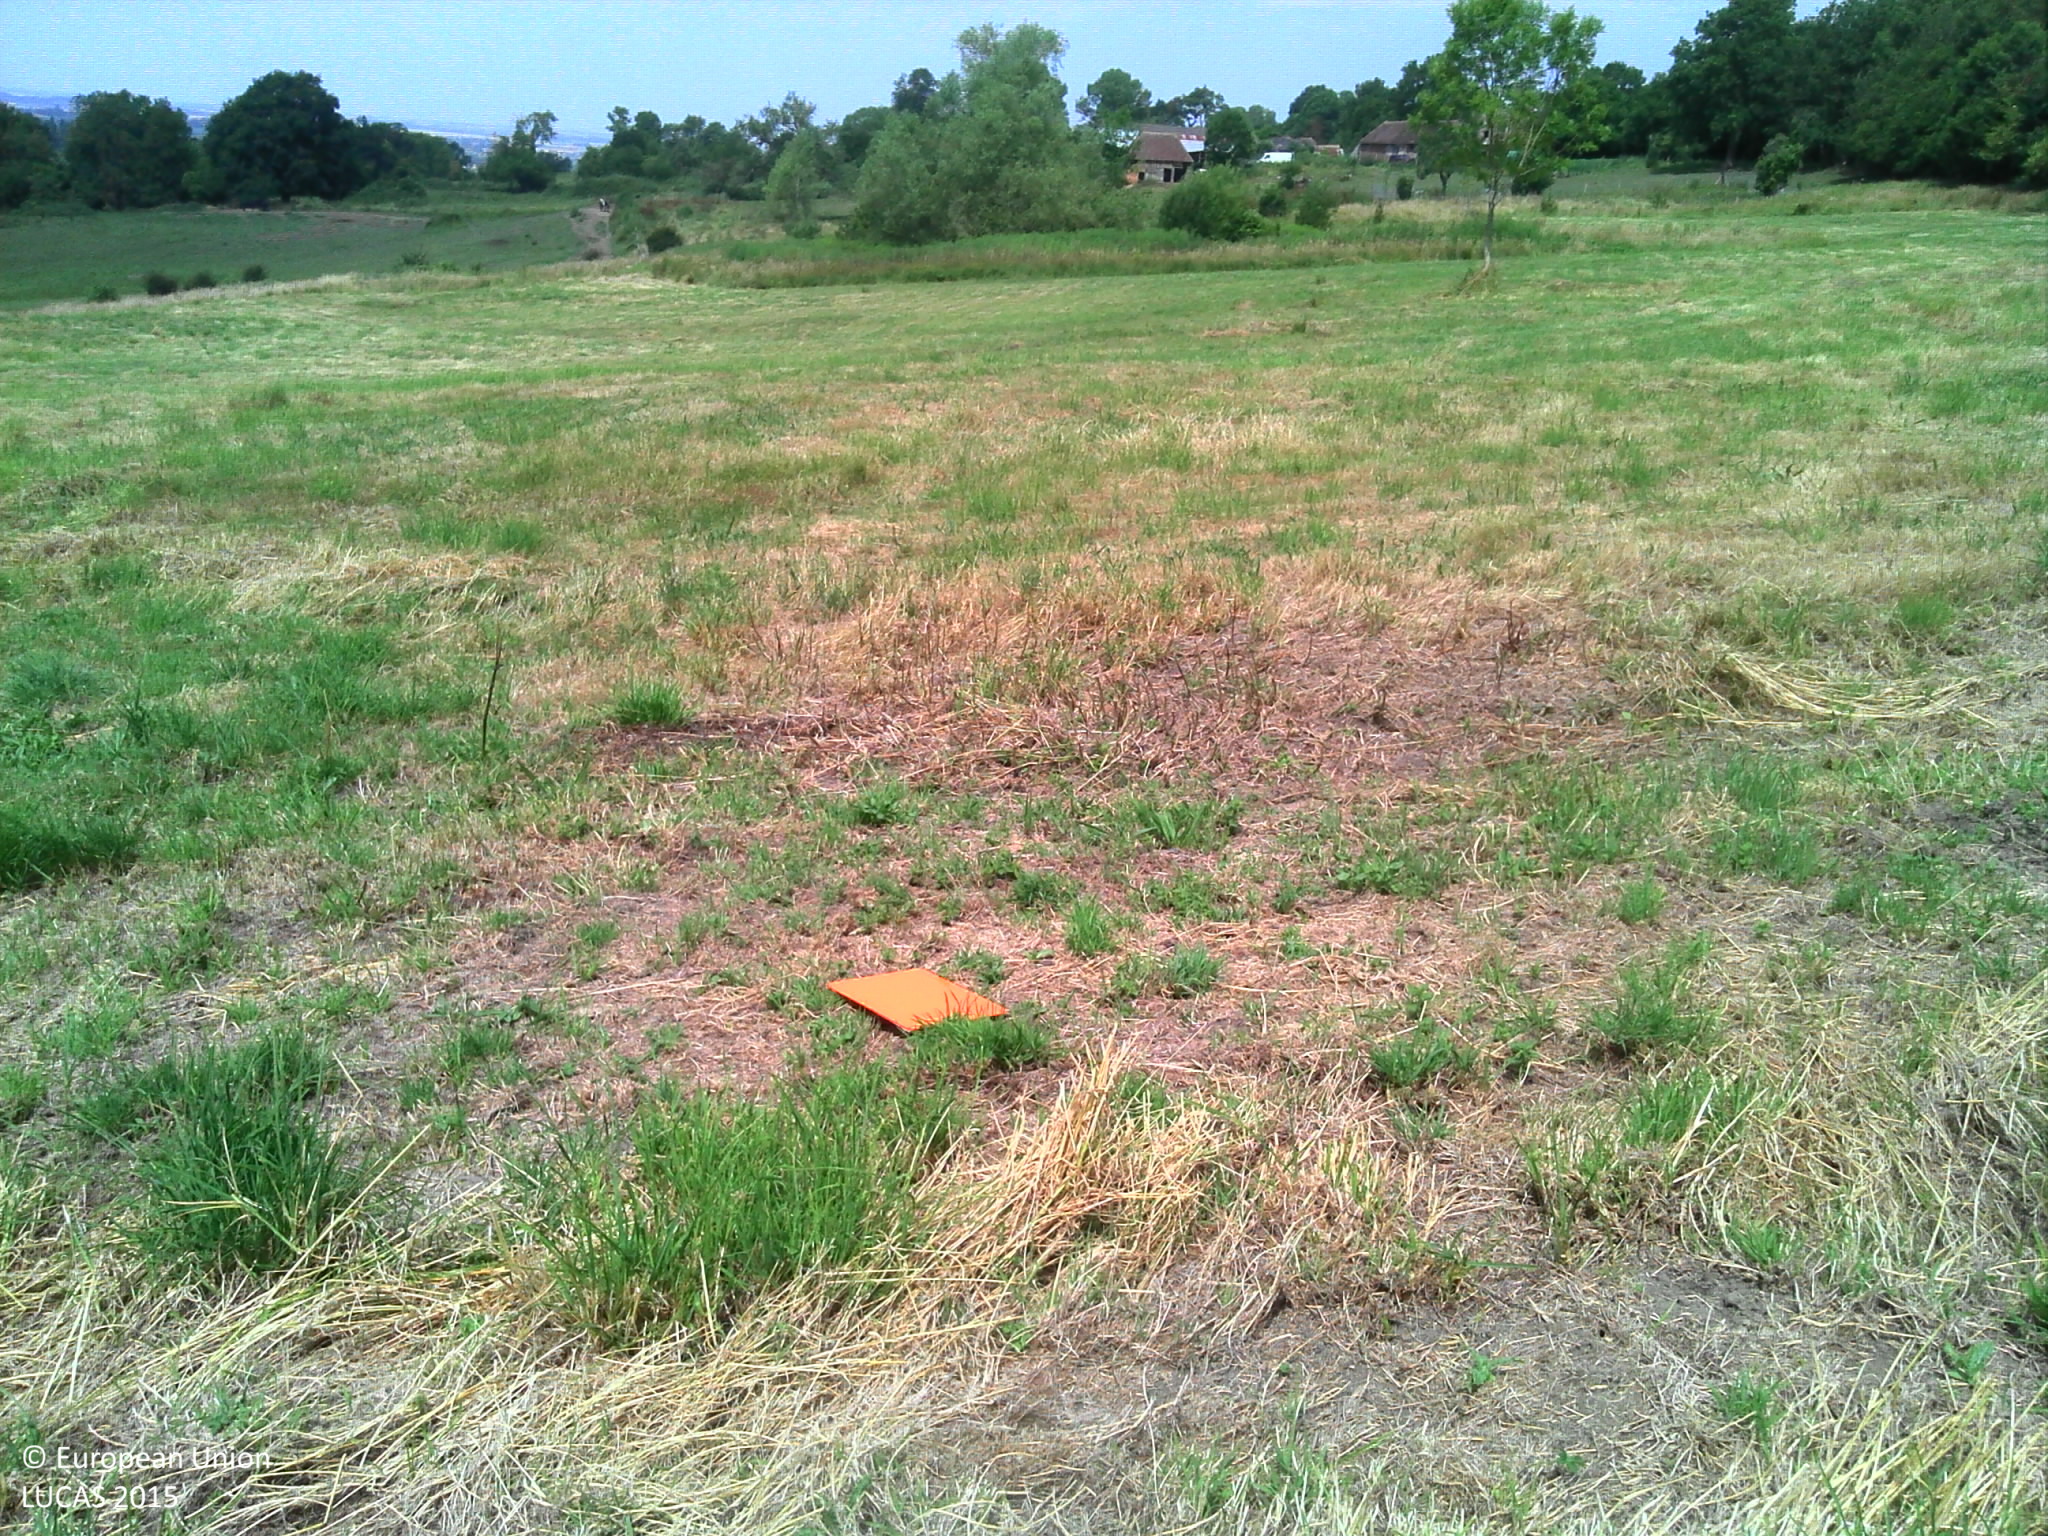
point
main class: Grassland
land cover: Grassland without tree/shrub cover
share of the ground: > 75 %
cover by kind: herbaceous plants 100 %
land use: Agriculture (excluding fallow land and kitchen gardens)
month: July
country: FR
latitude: 49.0259
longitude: 0.0823
